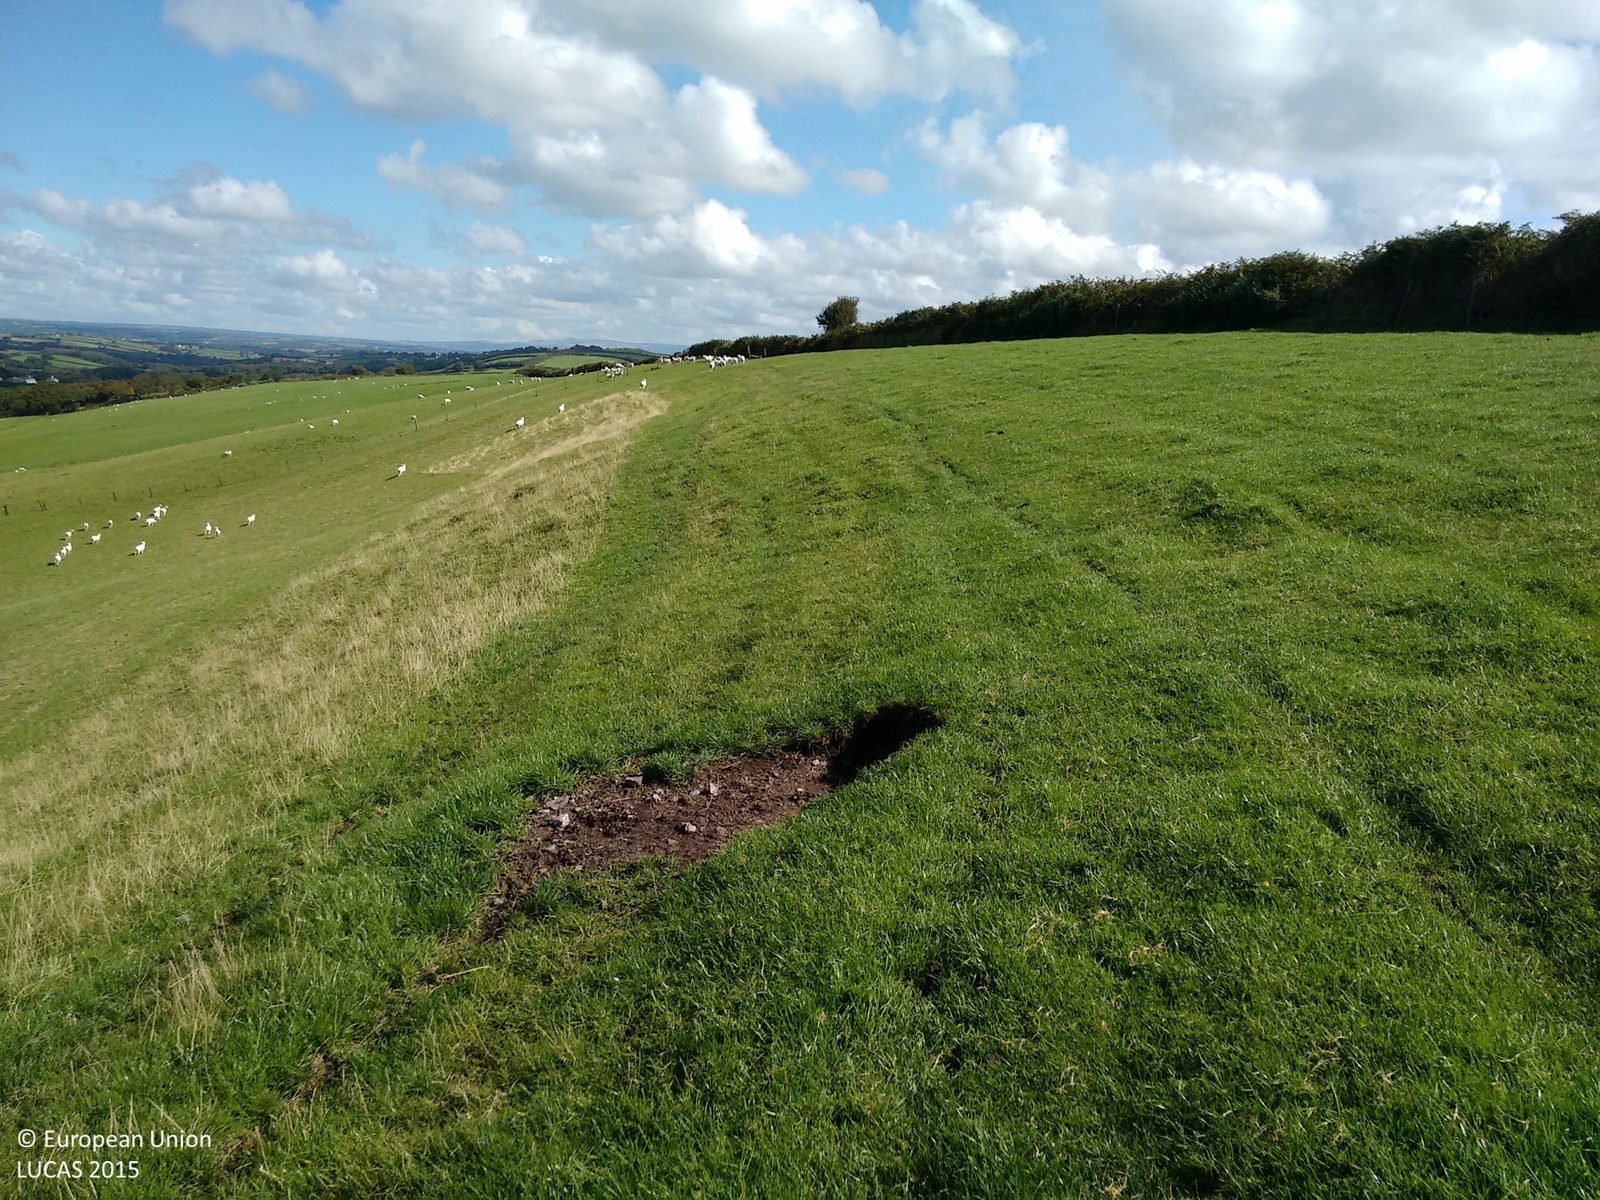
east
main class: Grassland
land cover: Grassland without tree/shrub cover
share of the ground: > 75 %
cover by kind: herbaceous plants 100 %
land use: Agriculture (excluding fallow land and kitchen gardens)
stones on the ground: < 10 %
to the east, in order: Grassland without tree/shrub cover; Fences; Grassland without tree/shrub cover; Fences; Managed hedges; Fences; Grassland without tree/shrub cover
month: September
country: GB
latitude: 50.6452
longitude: -4.4577
